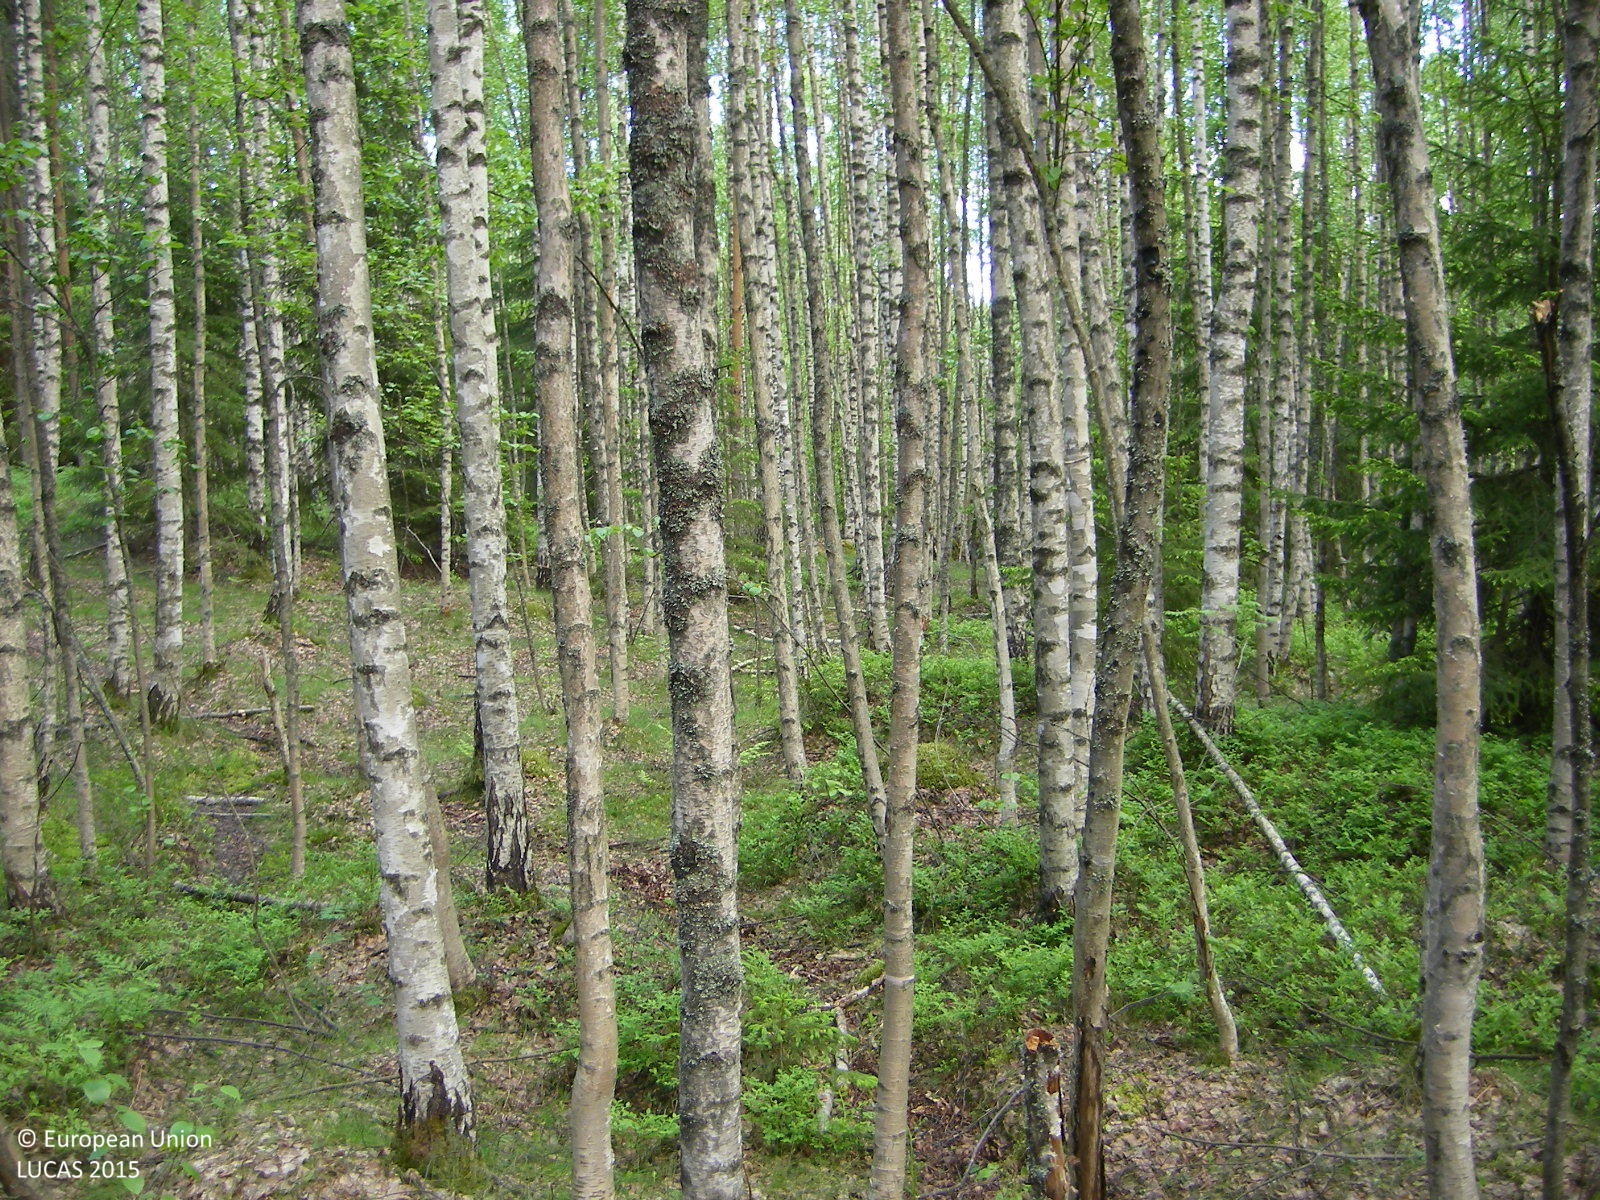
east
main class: Woodland
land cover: Spruce dominated mixed woodland
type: boreal forest
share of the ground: > 75 %
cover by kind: broadleaved forest trees 60 %, coniferous forest trees 30 %, herbaceous plants 5 %, lichens and mosses 5 %
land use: Forestry
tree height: > 5 m
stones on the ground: < 10 %
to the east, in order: Spruce dominated mixed woodland; Pine dominated mixed woodland; Other mixed woodland; Pine dominated mixed woodland; Spruce dominated mixed woodland; Tracks
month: June
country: FI
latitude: 60.1907
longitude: 24.5550
